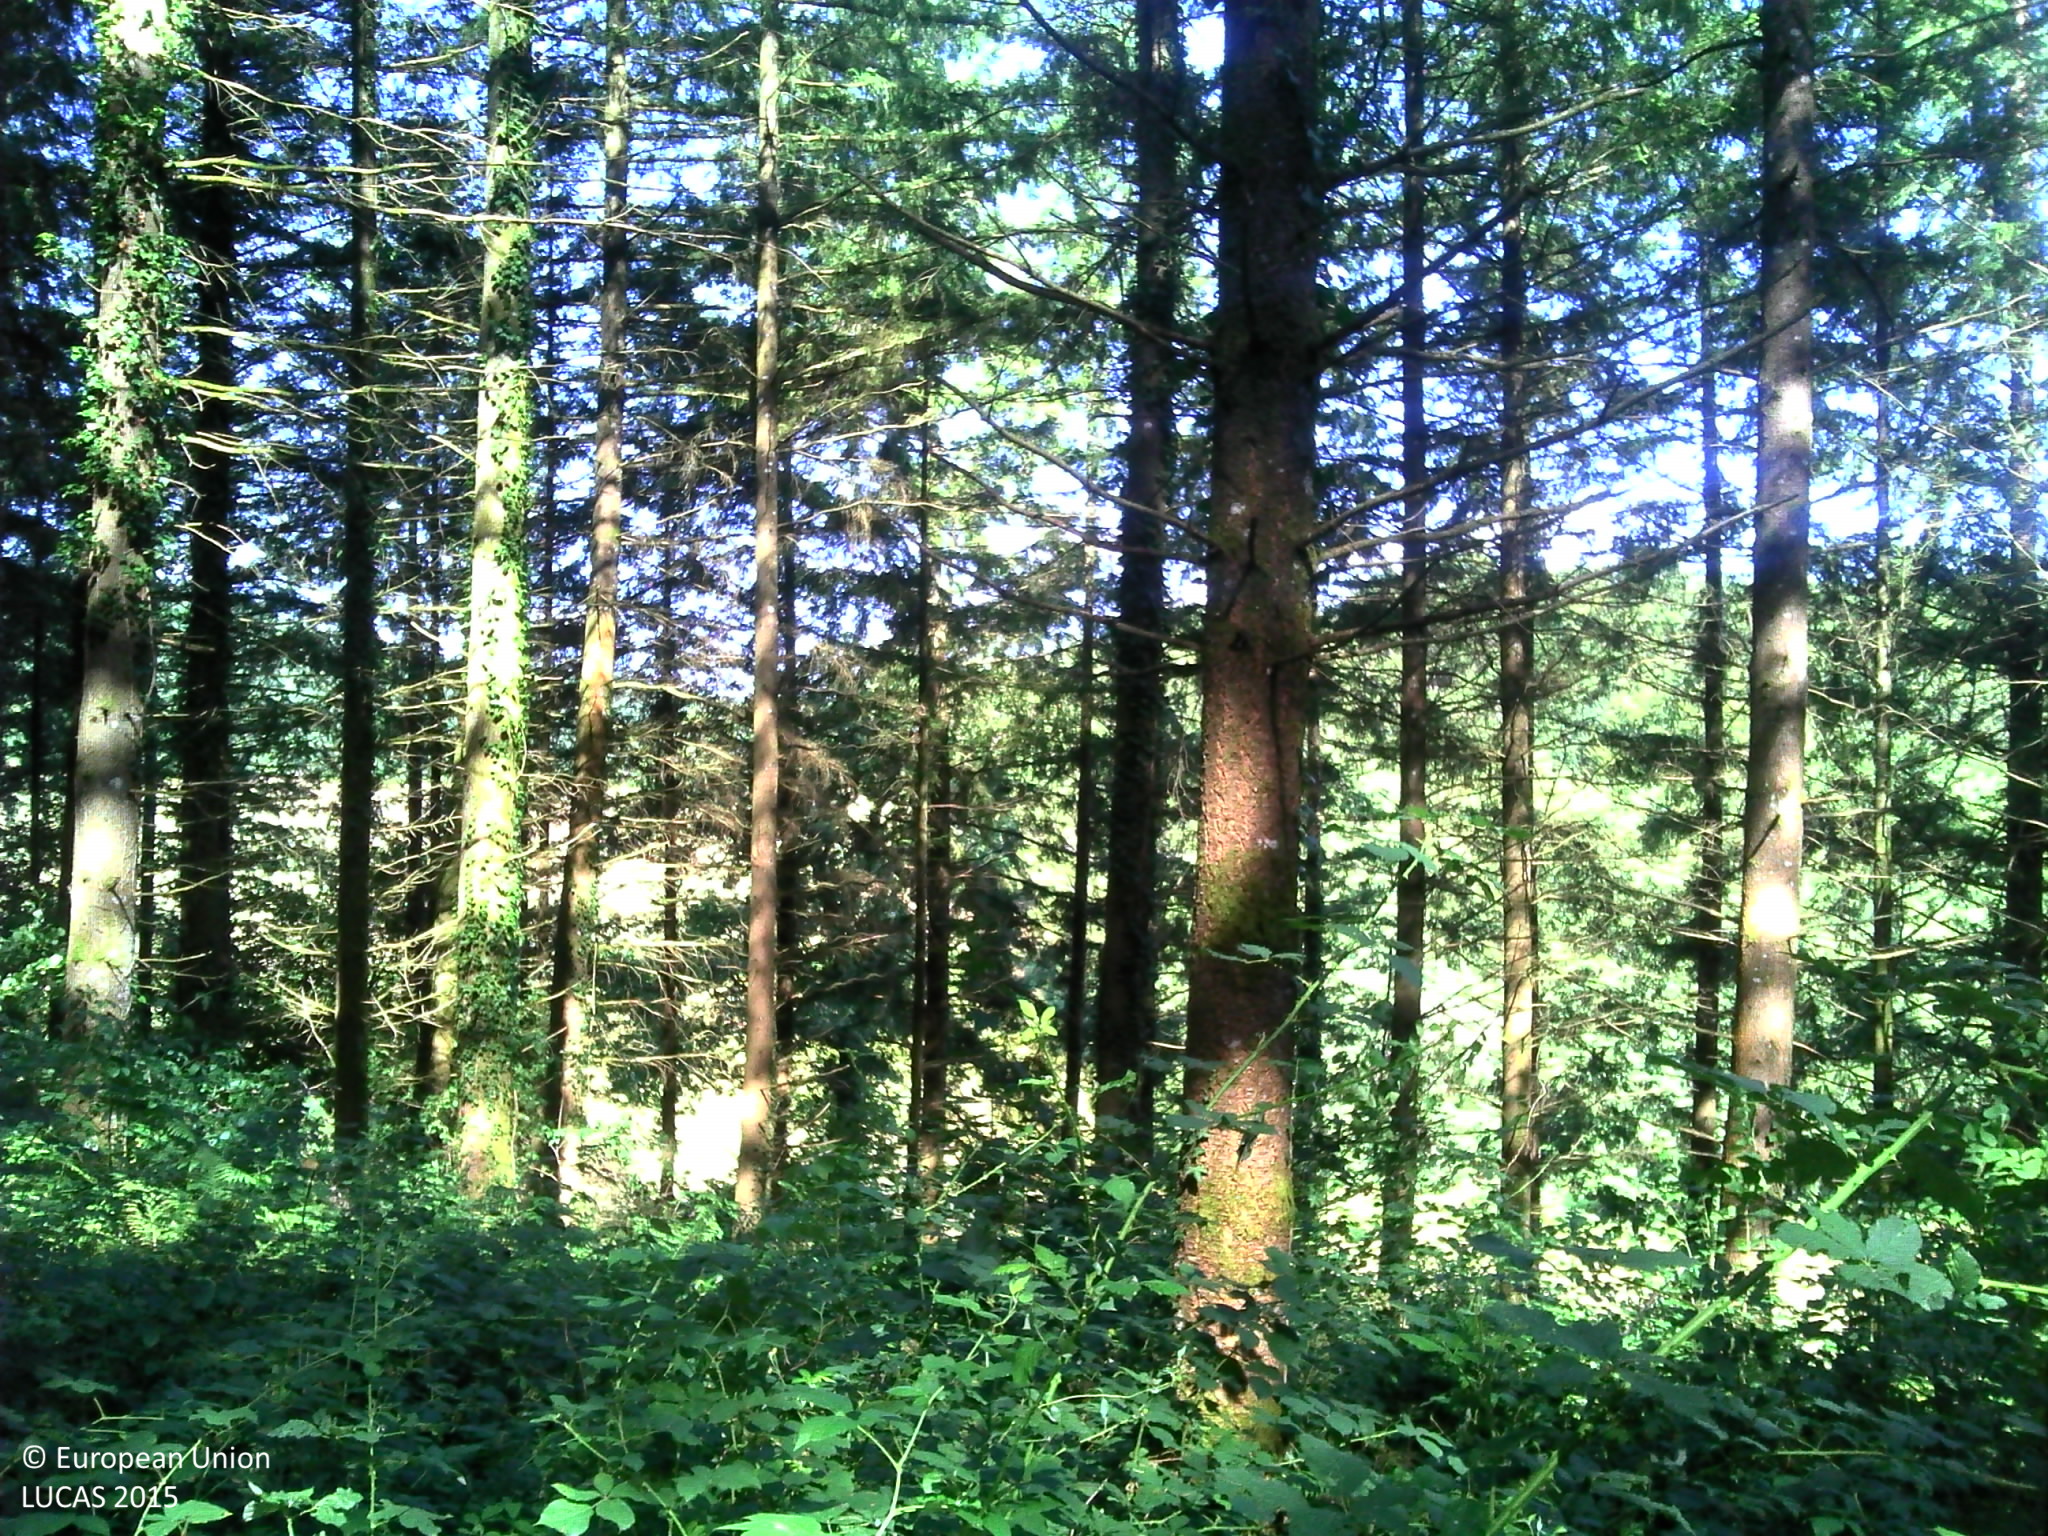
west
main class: Woodland
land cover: Spruce dominated coniferous woodland
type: exotic forest
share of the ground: > 75 %
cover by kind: coniferous forest trees 80 %, shrubs 10 %, herbaceous plants 10 %
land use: Forestry
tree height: > 5 m
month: July
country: FR
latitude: 45.6017
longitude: 1.8024
